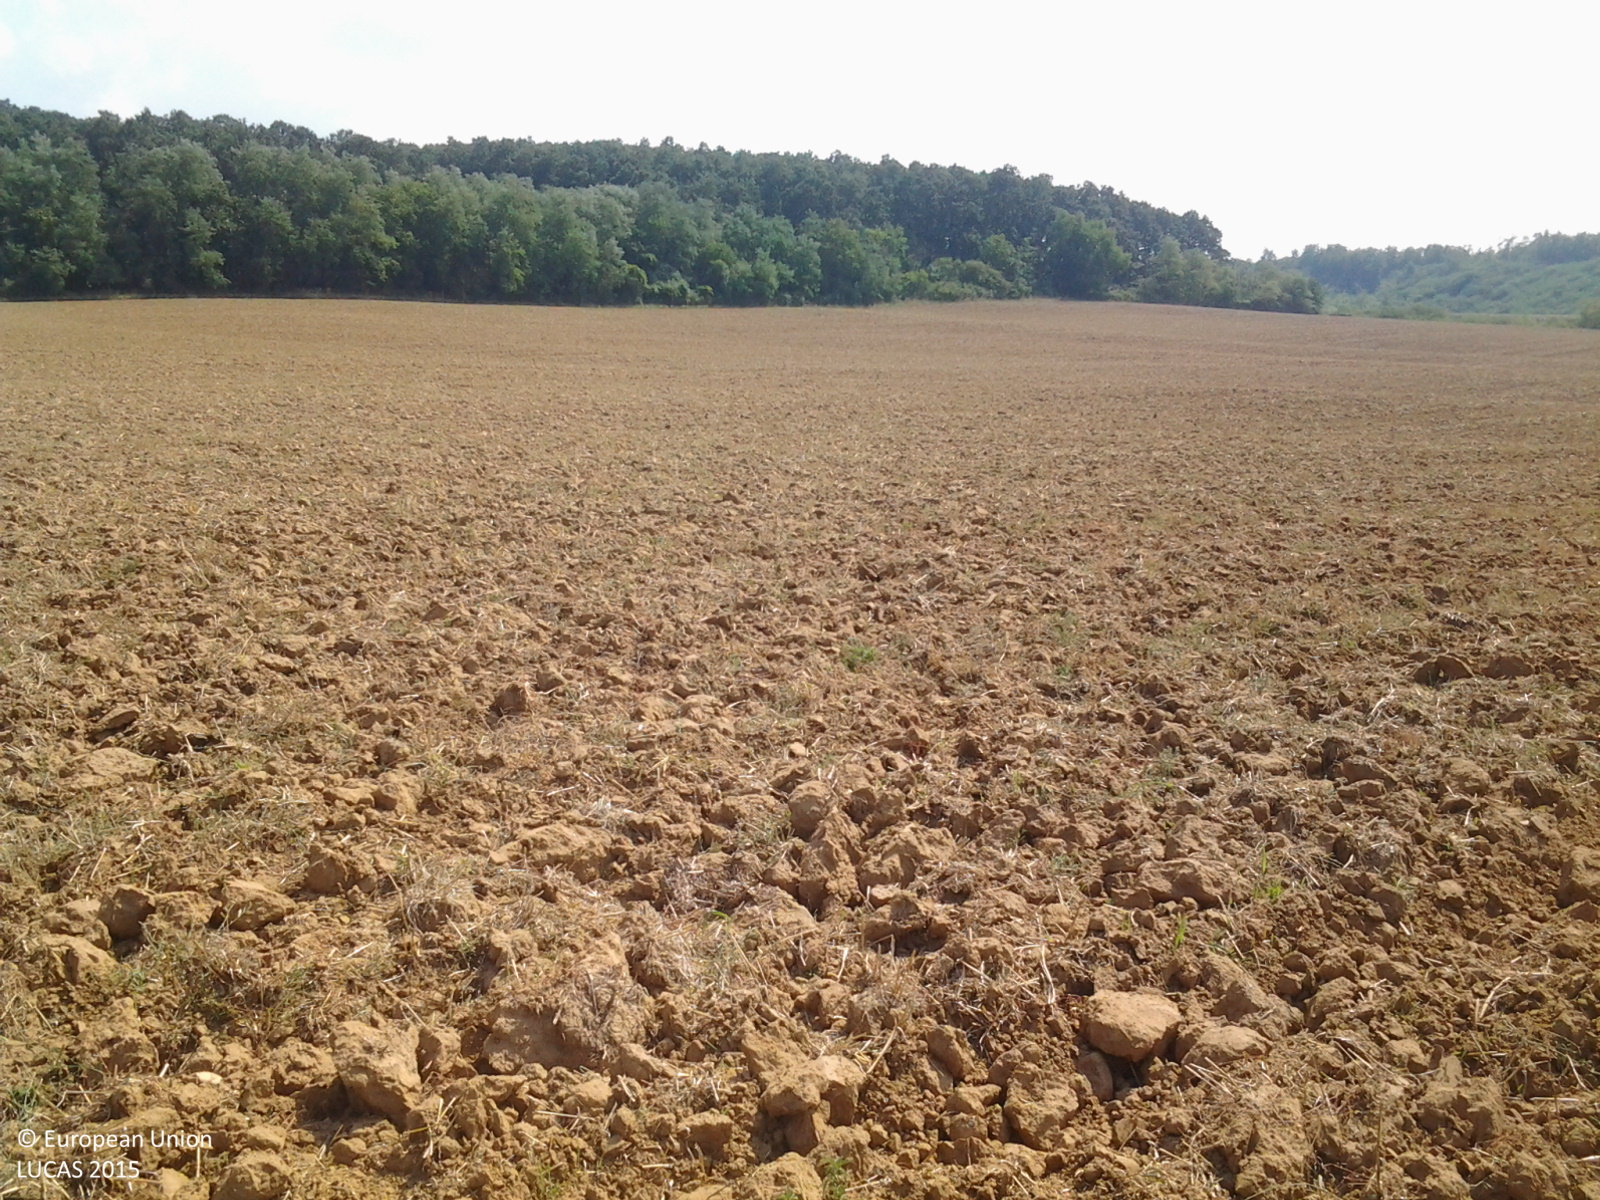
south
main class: Cropland
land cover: Barley
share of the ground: < 10 %
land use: Agriculture (excluding fallow land and kitchen gardens)
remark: Harvested field
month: August
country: HU
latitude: 46.4604
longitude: 18.3294
